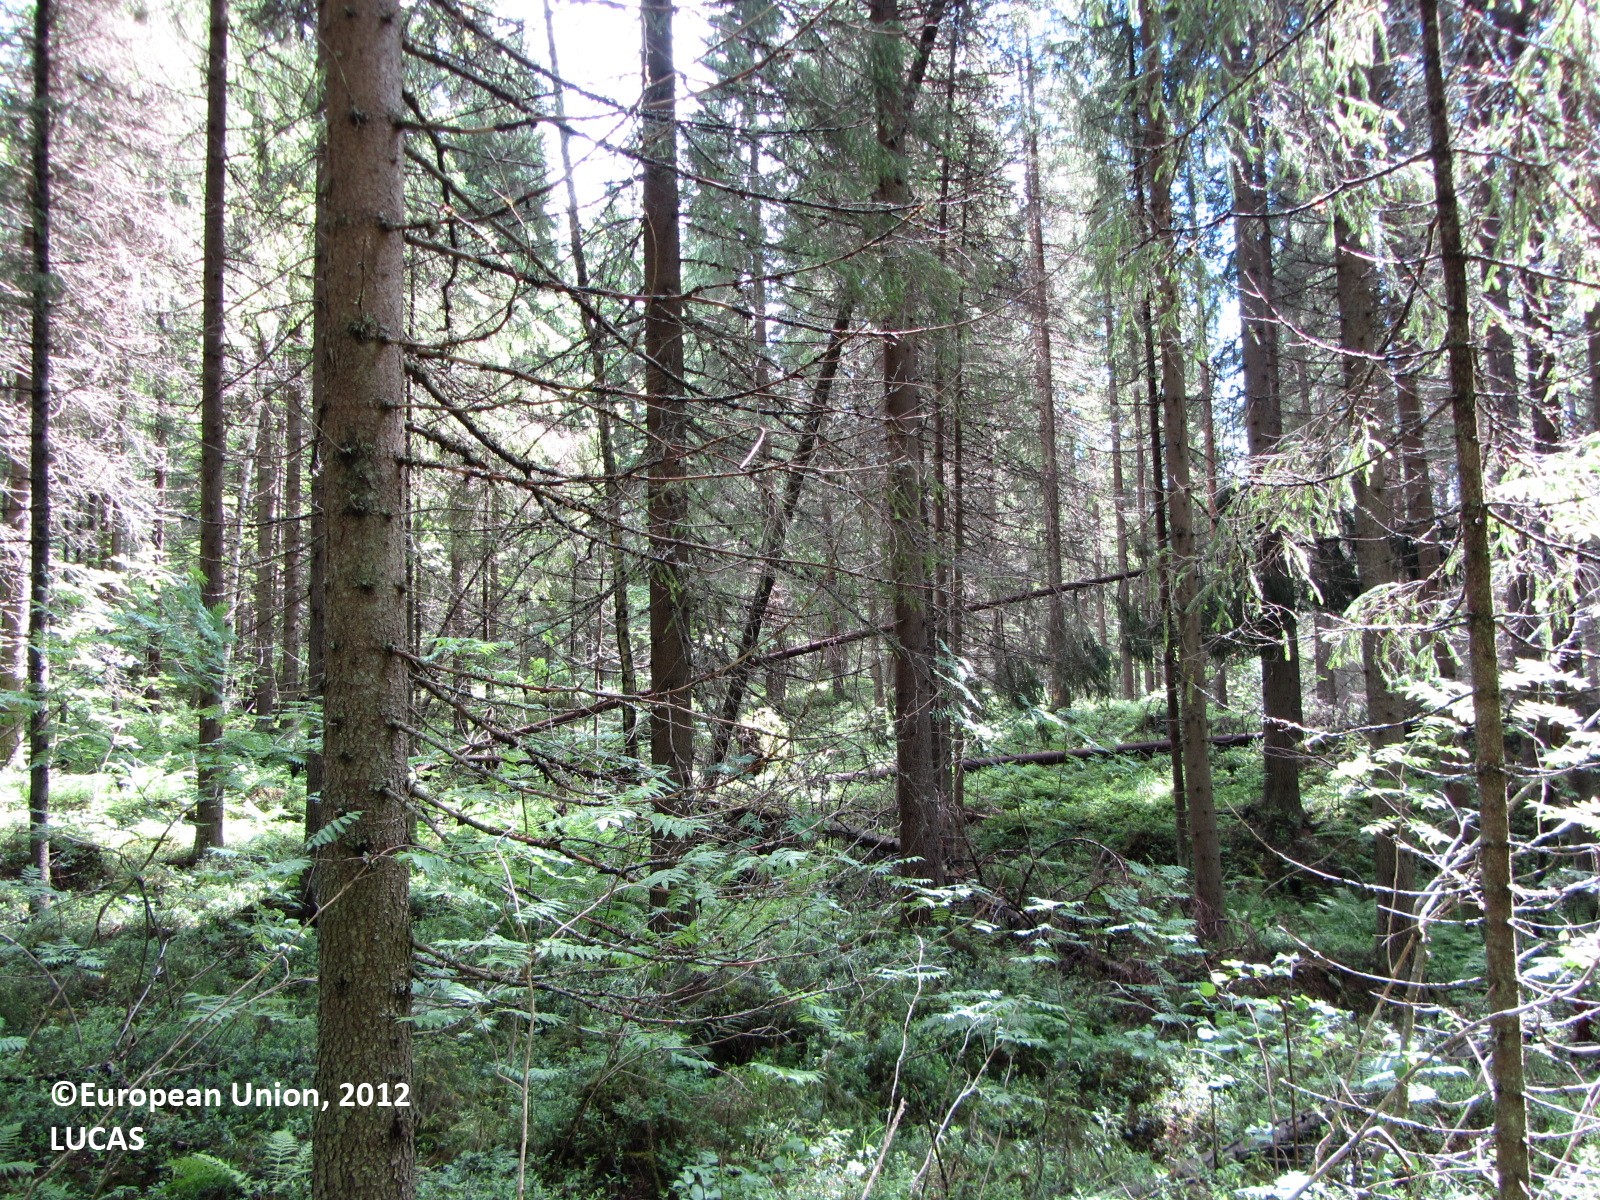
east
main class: Woodland
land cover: Spruce dominated coniferous woodland
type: boreal forest
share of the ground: > 75 %
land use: Forestry
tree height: > 5 m
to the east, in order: Spruce dominated coniferous woodland; Rivers and streams; Spruce dominated coniferous woodland; Grassland with sparse tree/shrub cover; Spruce dominated coniferous woodland; Shrubland with sparse tree cover; Spruce dominated coniferous woodland; Grassland with sparse tree/shrub cover; Spruce dominated mixed woodland; Spruce dominated coniferous woodland; Shrubland with sparse tree cover; Spruce dominated coniferous woodland; Paved roads, cycling and walking lanes
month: June
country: FI
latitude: 61.9907
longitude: 25.2865
